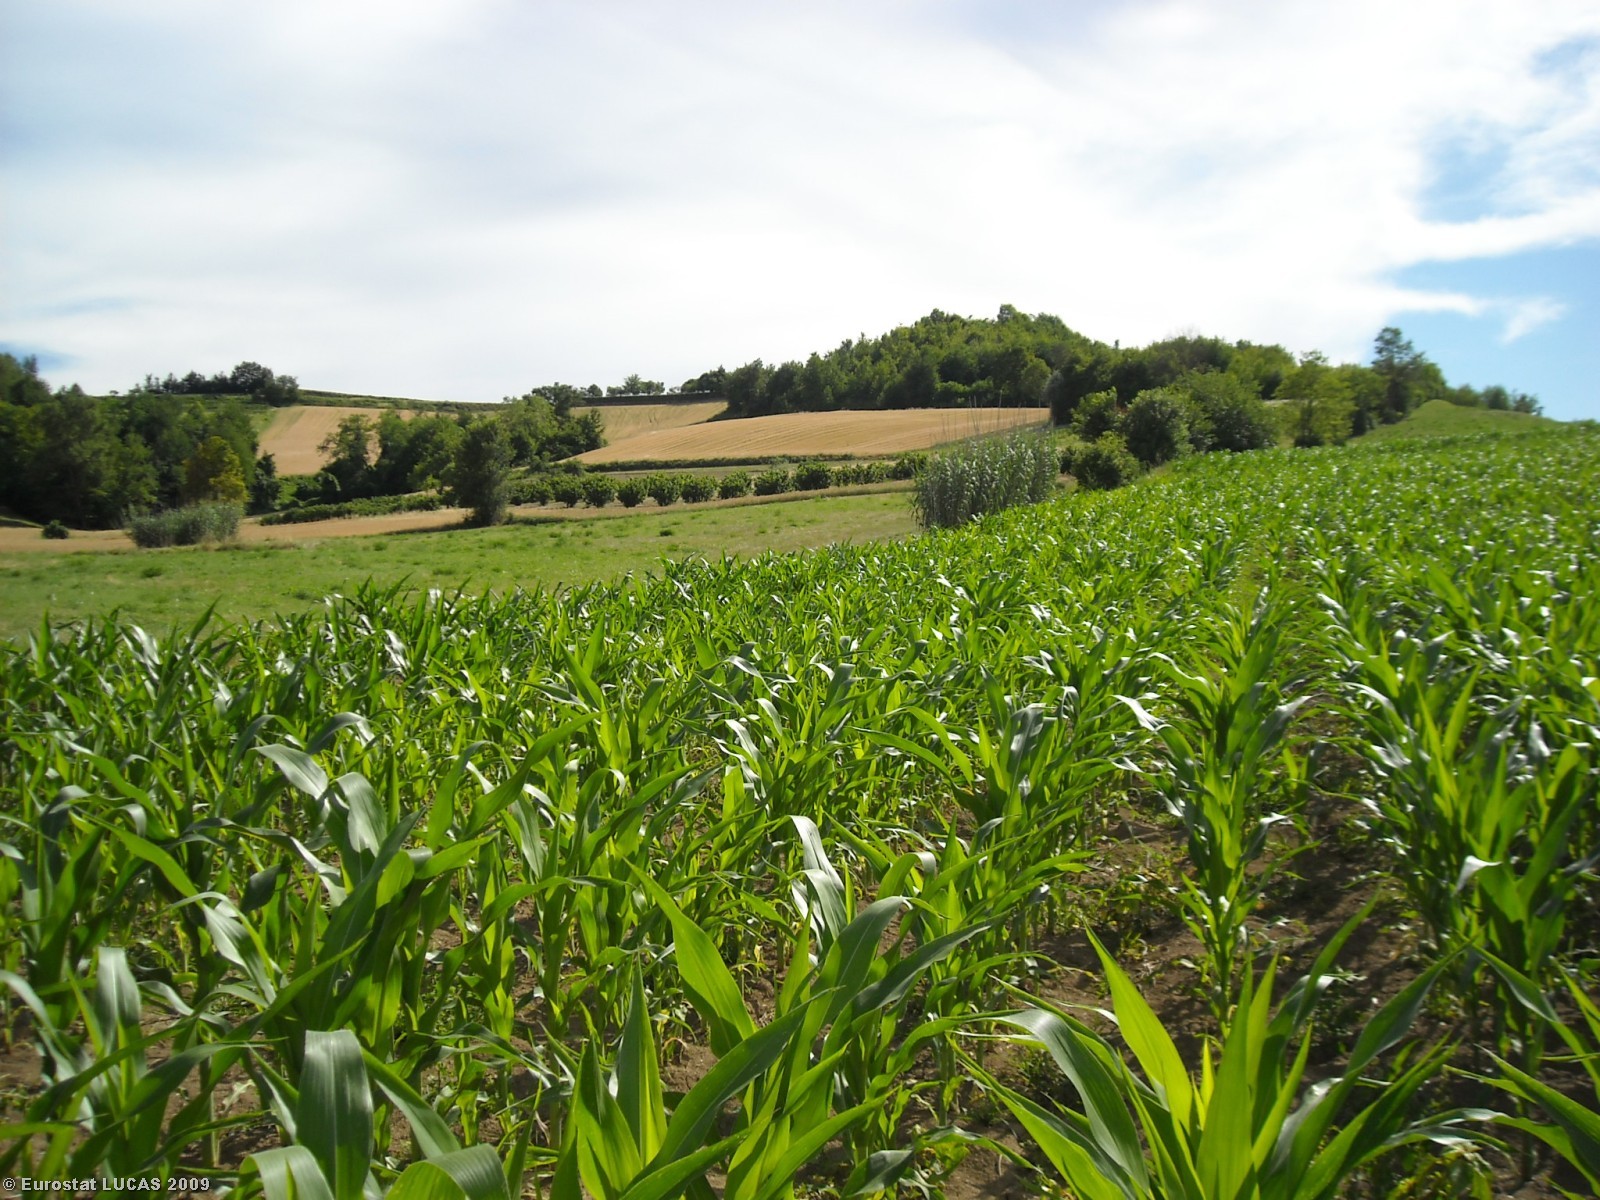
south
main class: Cropland
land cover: Maize
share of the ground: > 75 %
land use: Agriculture (excluding fallow land and kitchen gardens)
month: June
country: IT
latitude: 45.0544
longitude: 8.0861
